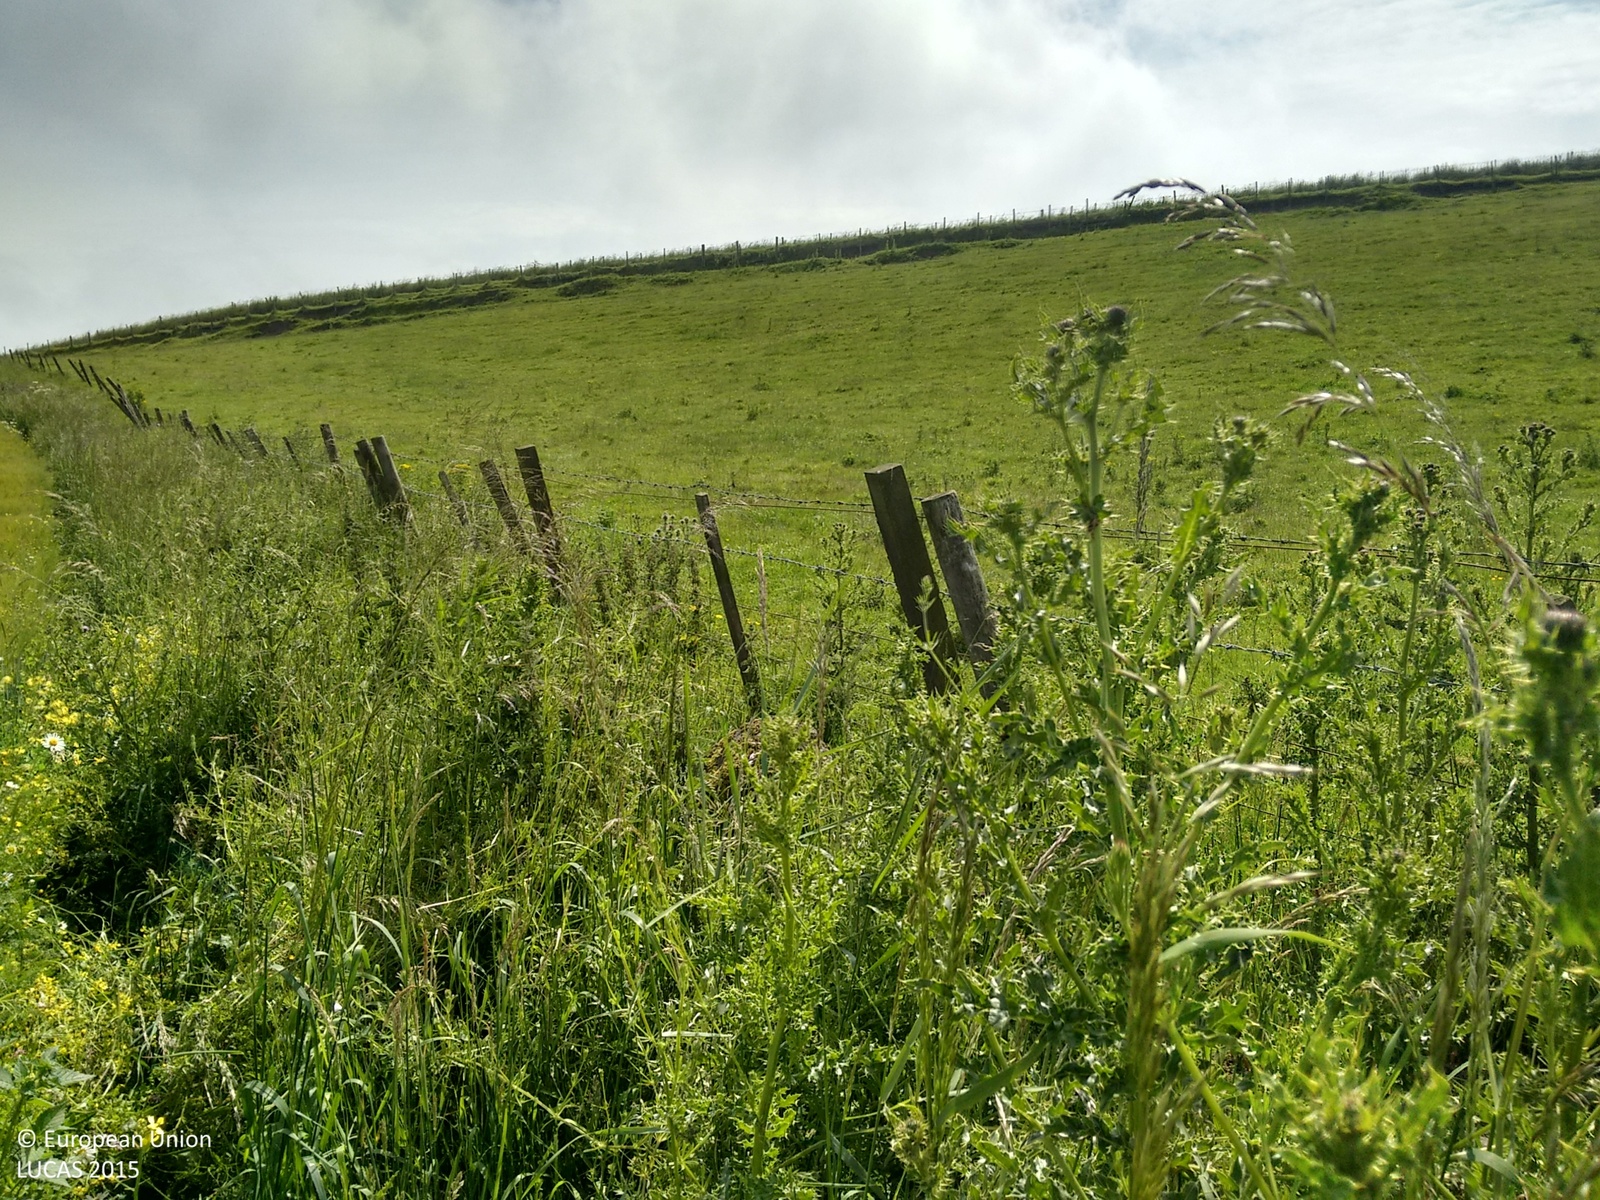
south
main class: Cropland
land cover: Barley
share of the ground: > 75 %
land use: Agriculture (excluding fallow land and kitchen gardens)
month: July
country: GB
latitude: 56.0825
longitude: -3.2323
